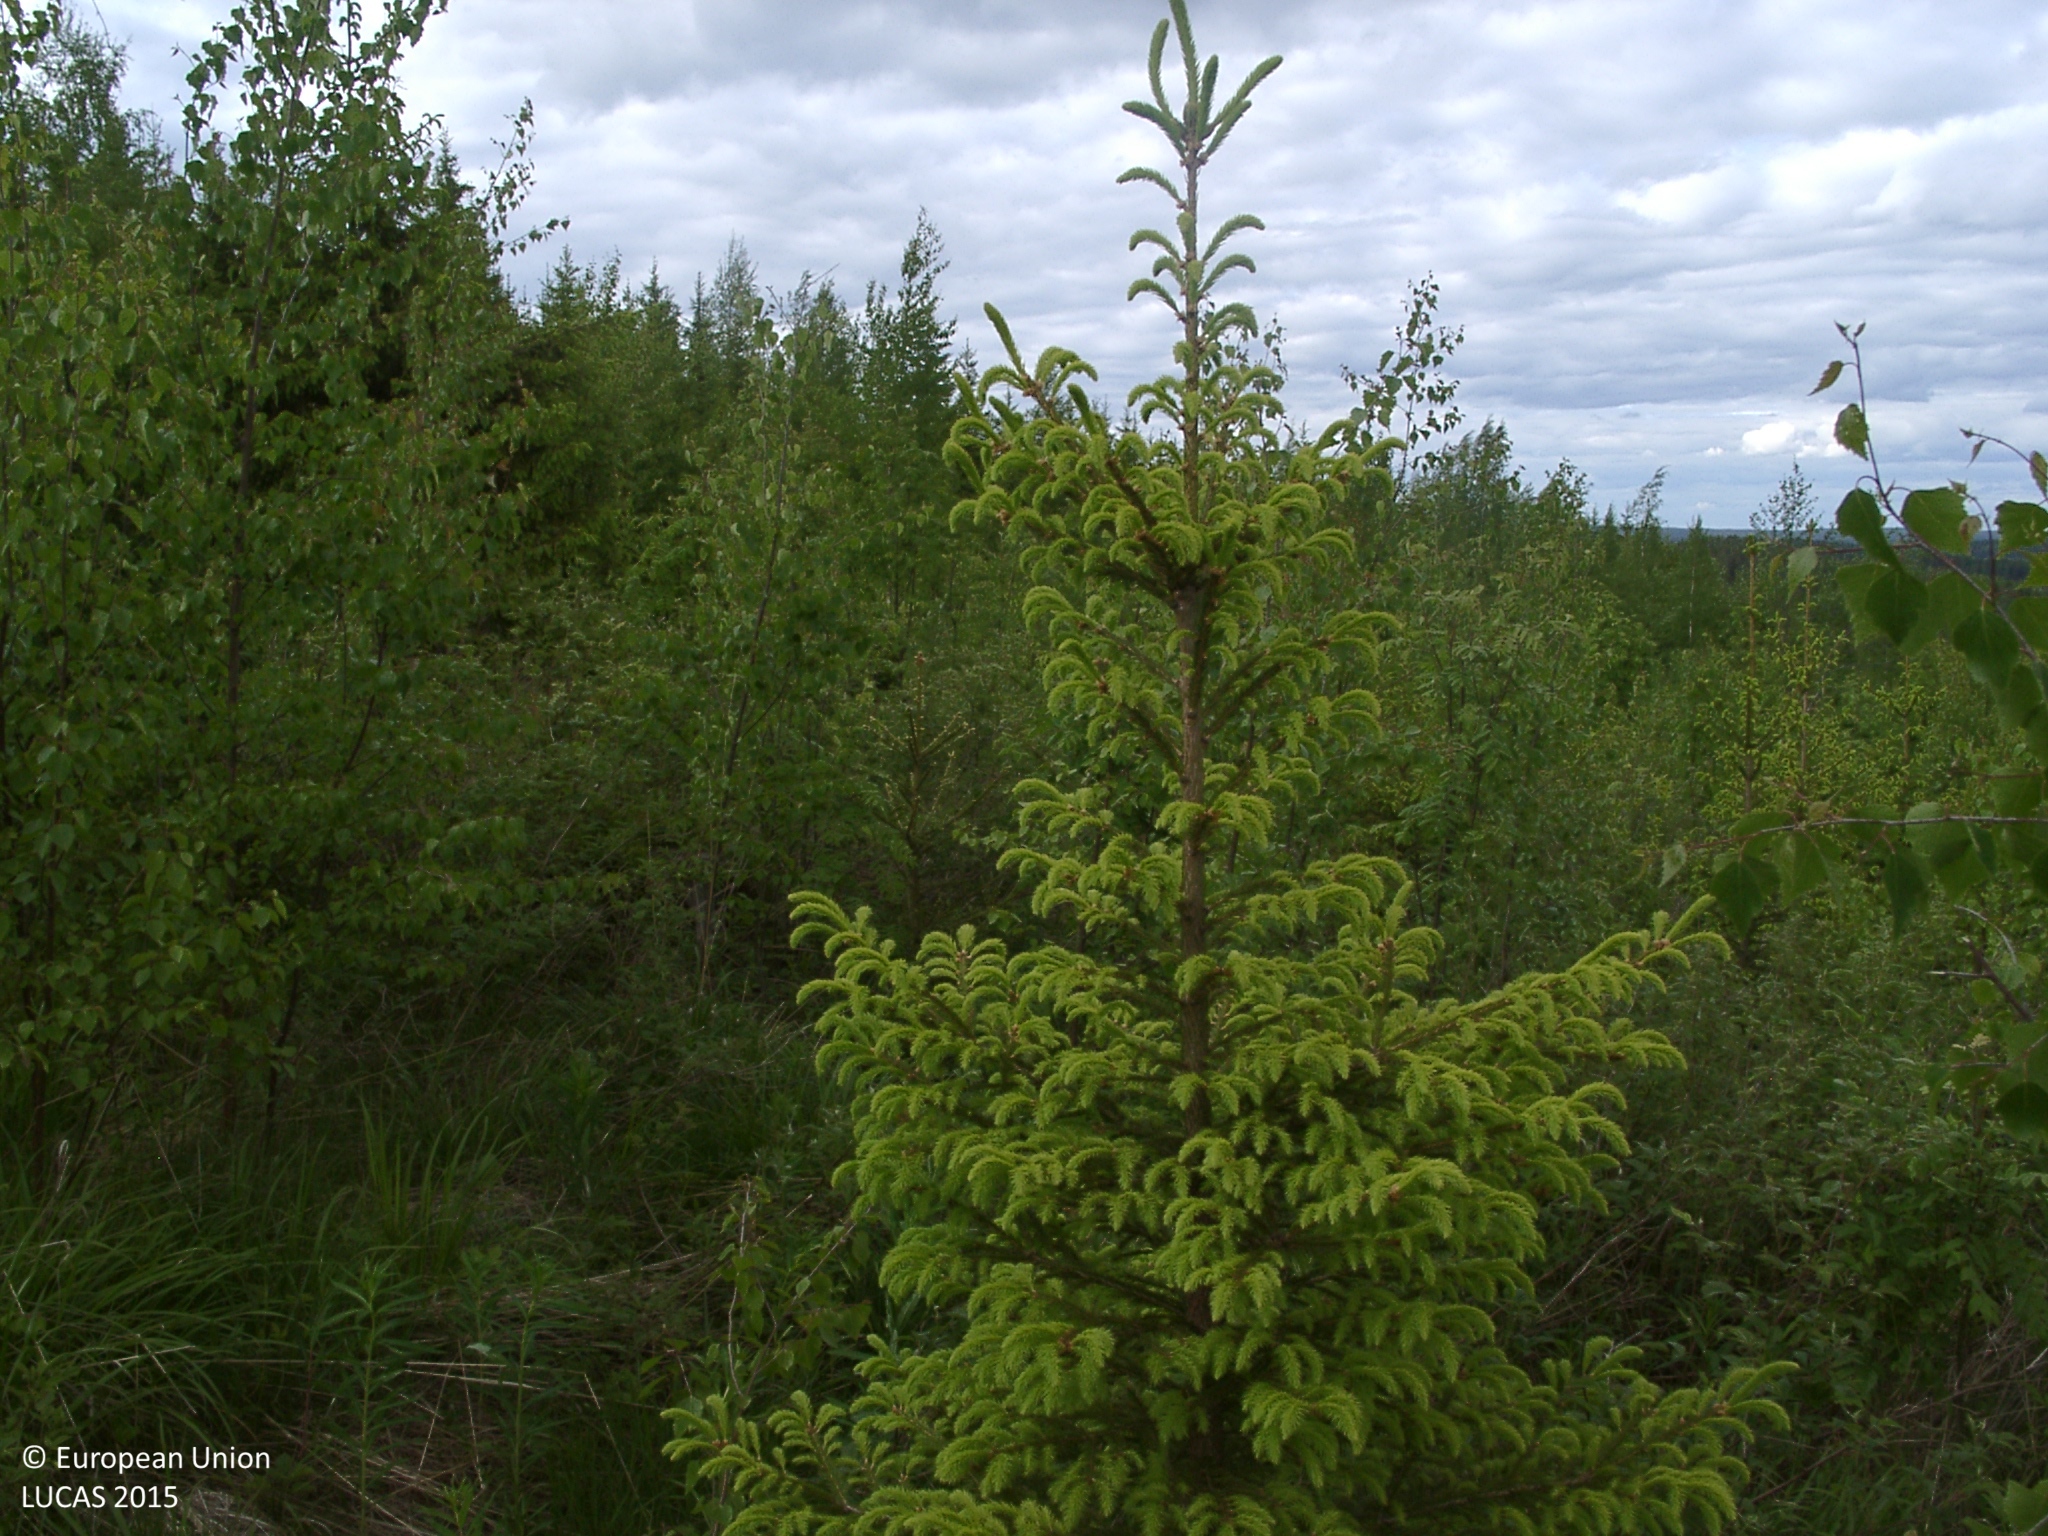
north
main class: Woodland
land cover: Spruce dominated mixed woodland
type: boreal forest
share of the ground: 50 - 75 %
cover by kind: broadleaved forest trees 45 %, coniferous forest trees 25 %, shrubs 15 %, herbaceous plants 15 %
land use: Forestry
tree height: < 5 m
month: June
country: FI
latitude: 62.4532
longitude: 25.7997
